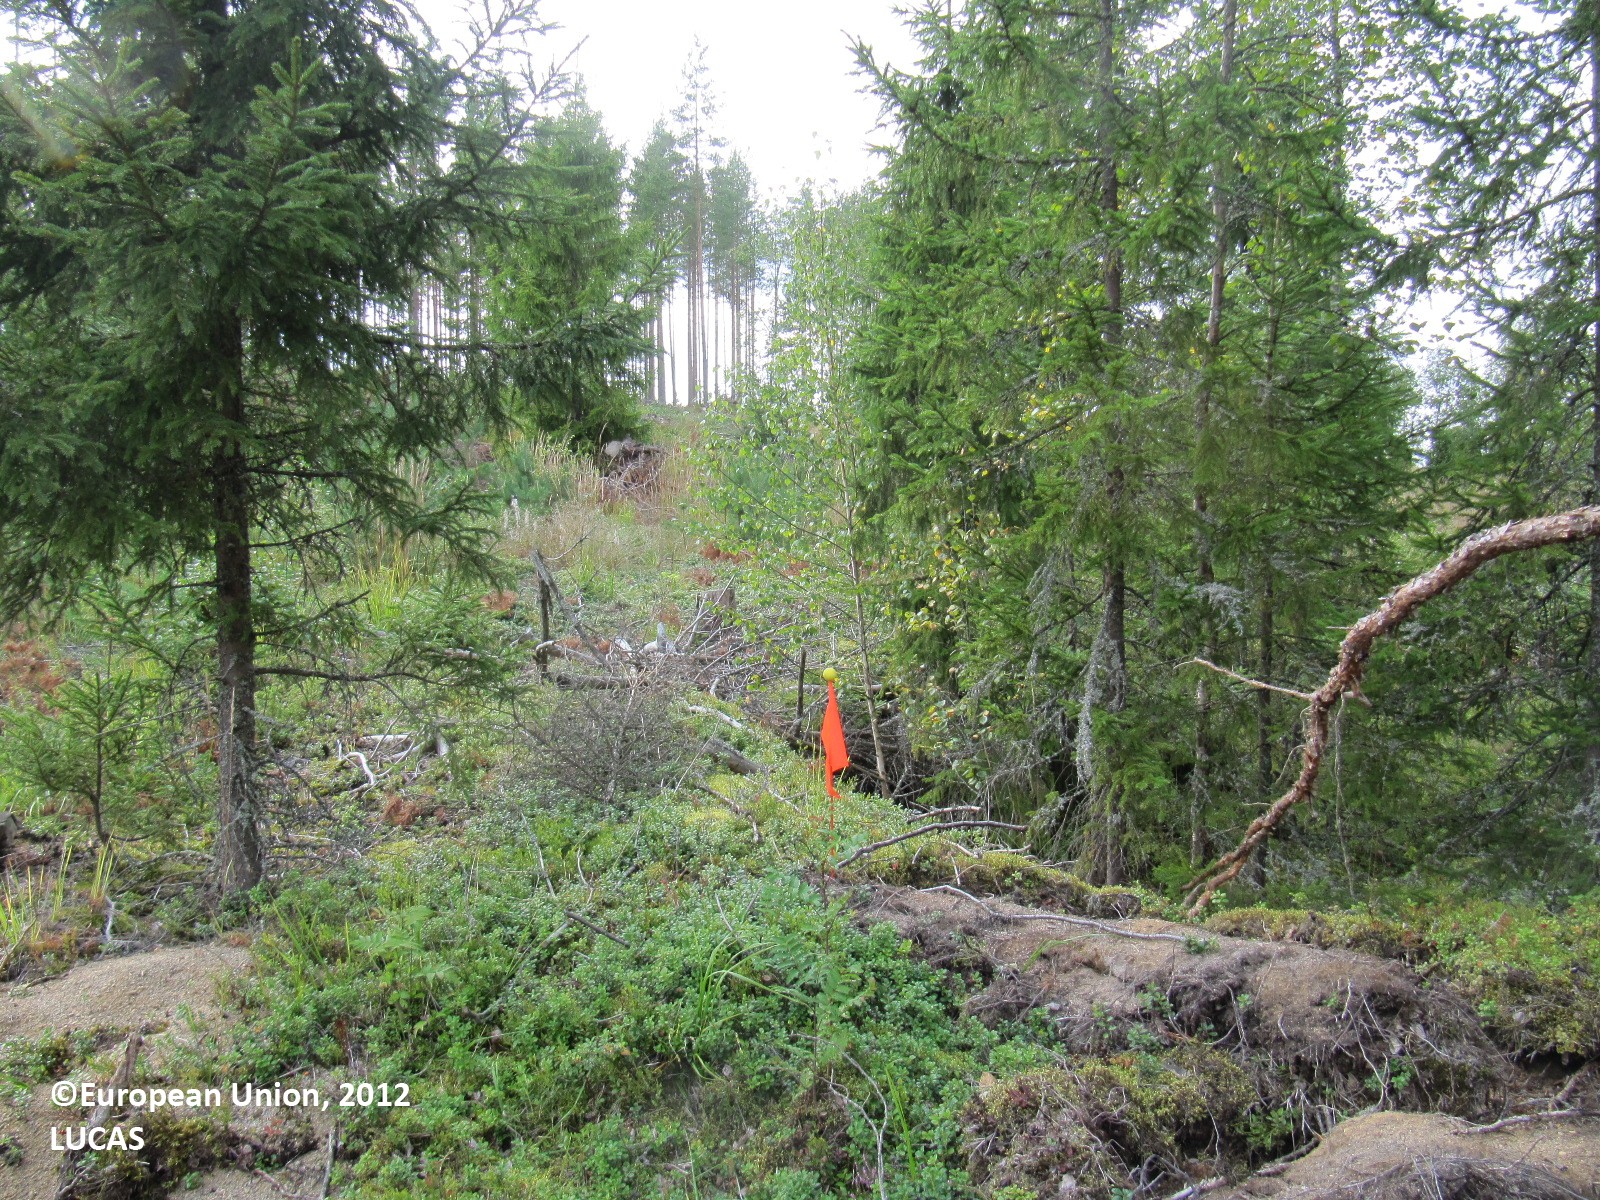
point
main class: Woodland
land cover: Spruce dominated mixed woodland
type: boreal forest
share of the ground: 50 - 75 %
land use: Forestry
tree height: > 5 m
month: August
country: FI
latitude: 61.1036
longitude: 22.8911
